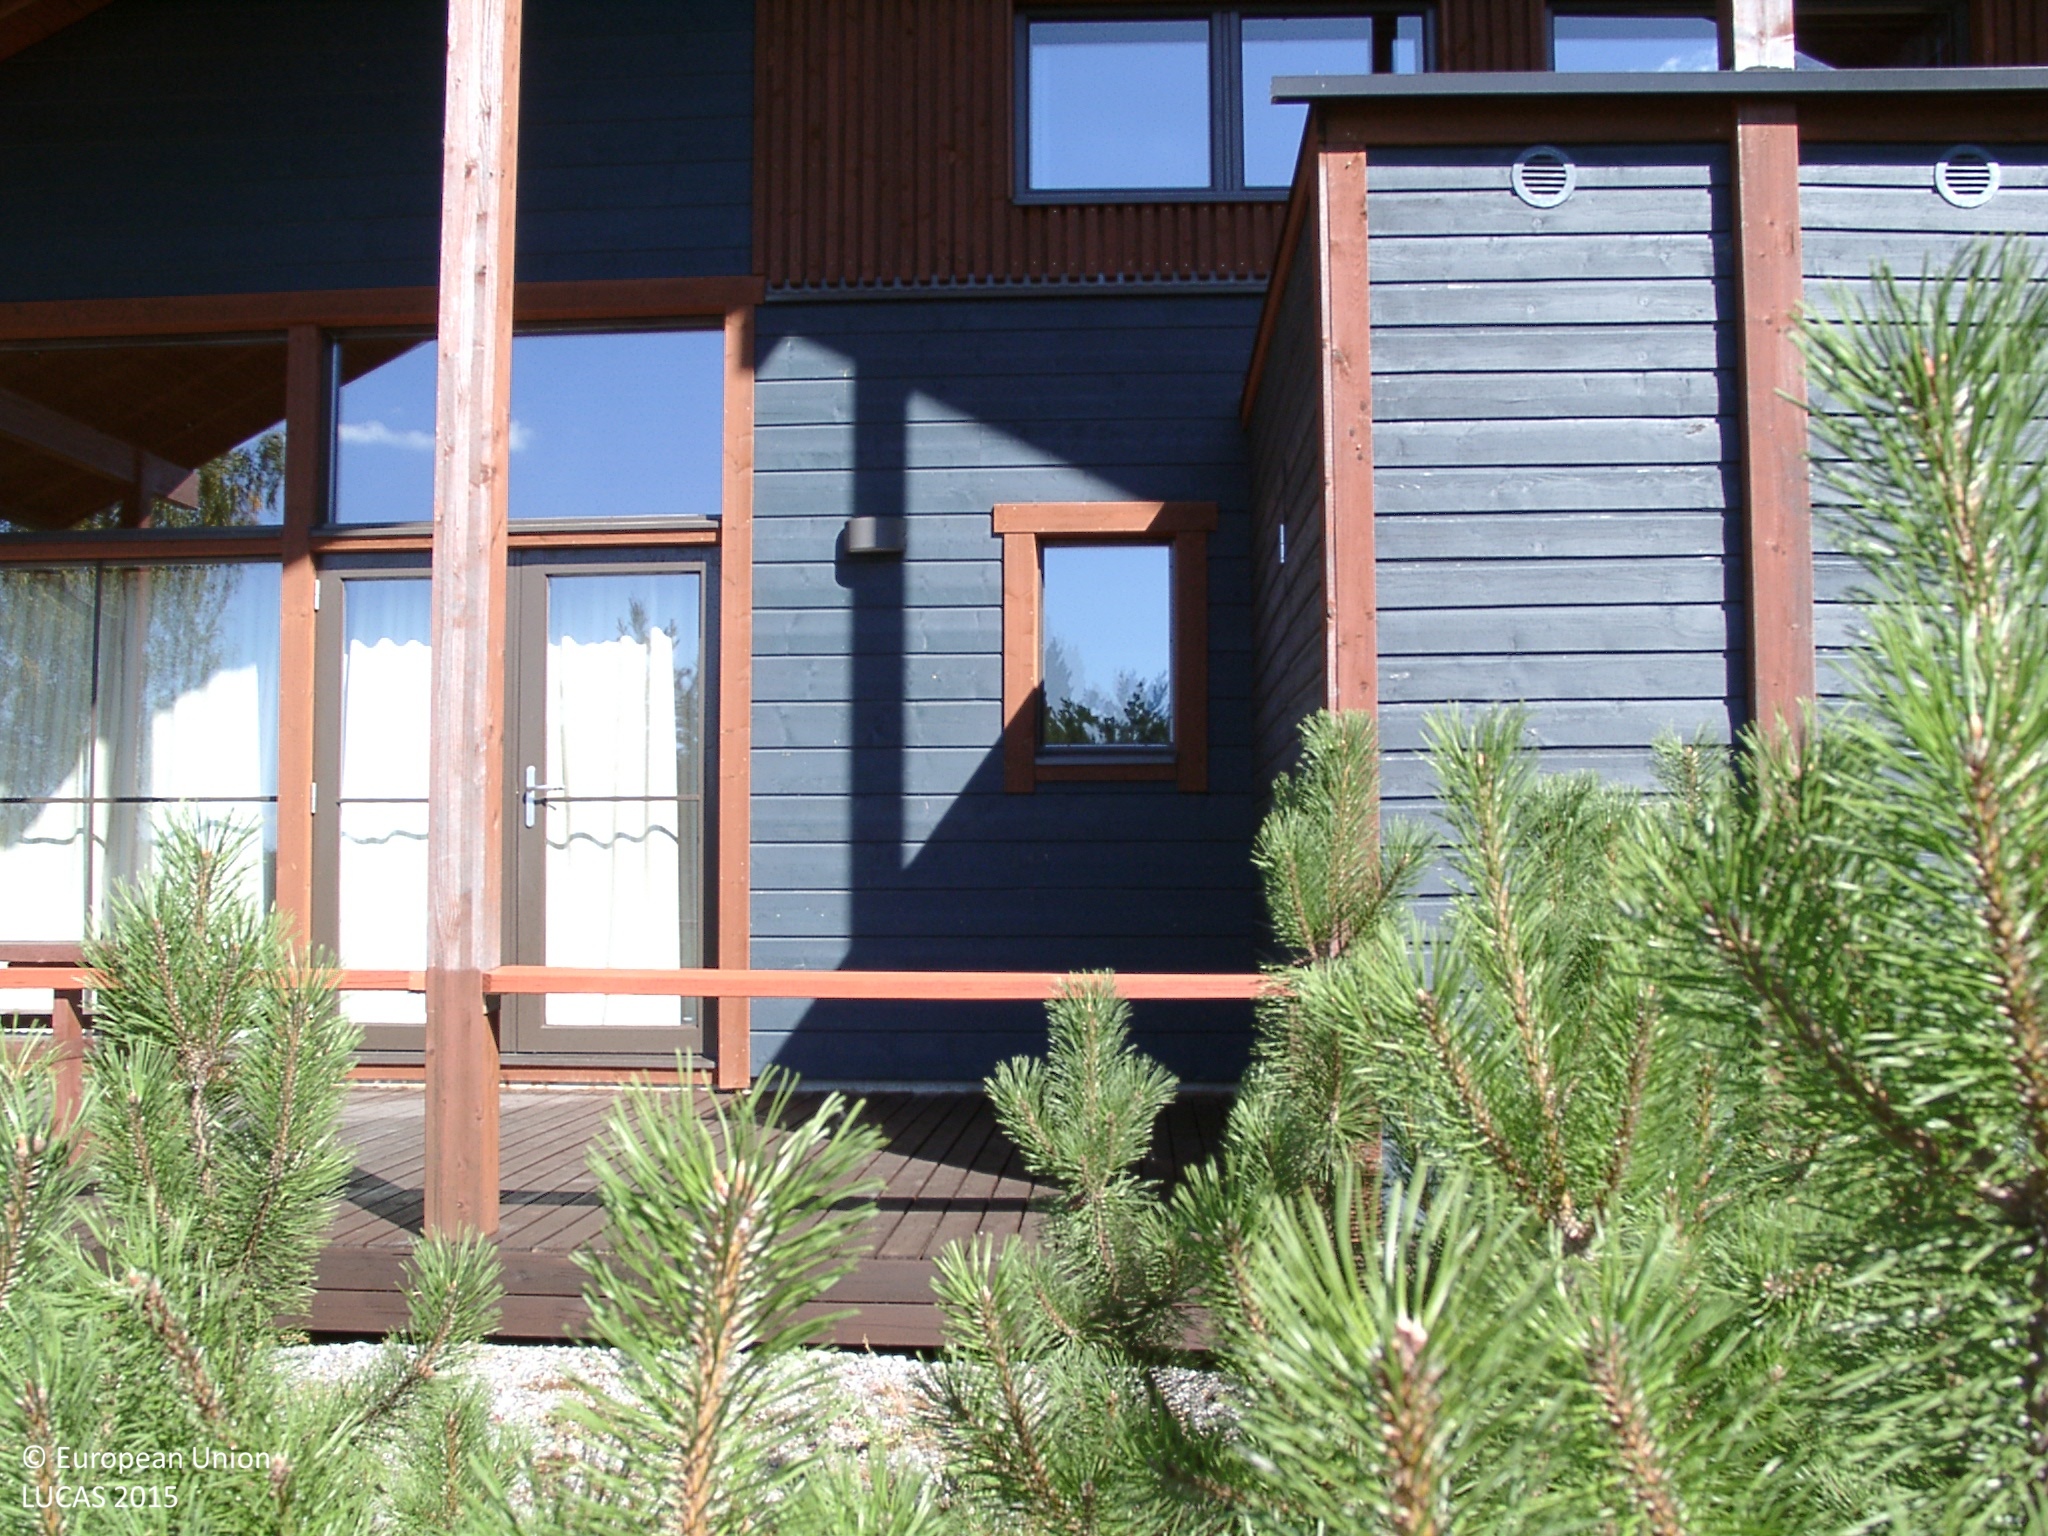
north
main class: Grassland
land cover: Spontaneously vegetated surfaces
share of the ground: > 75 %
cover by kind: herbaceous plants 100 %
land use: Residential
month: August
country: FI
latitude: 61.8954
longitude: 25.3170
